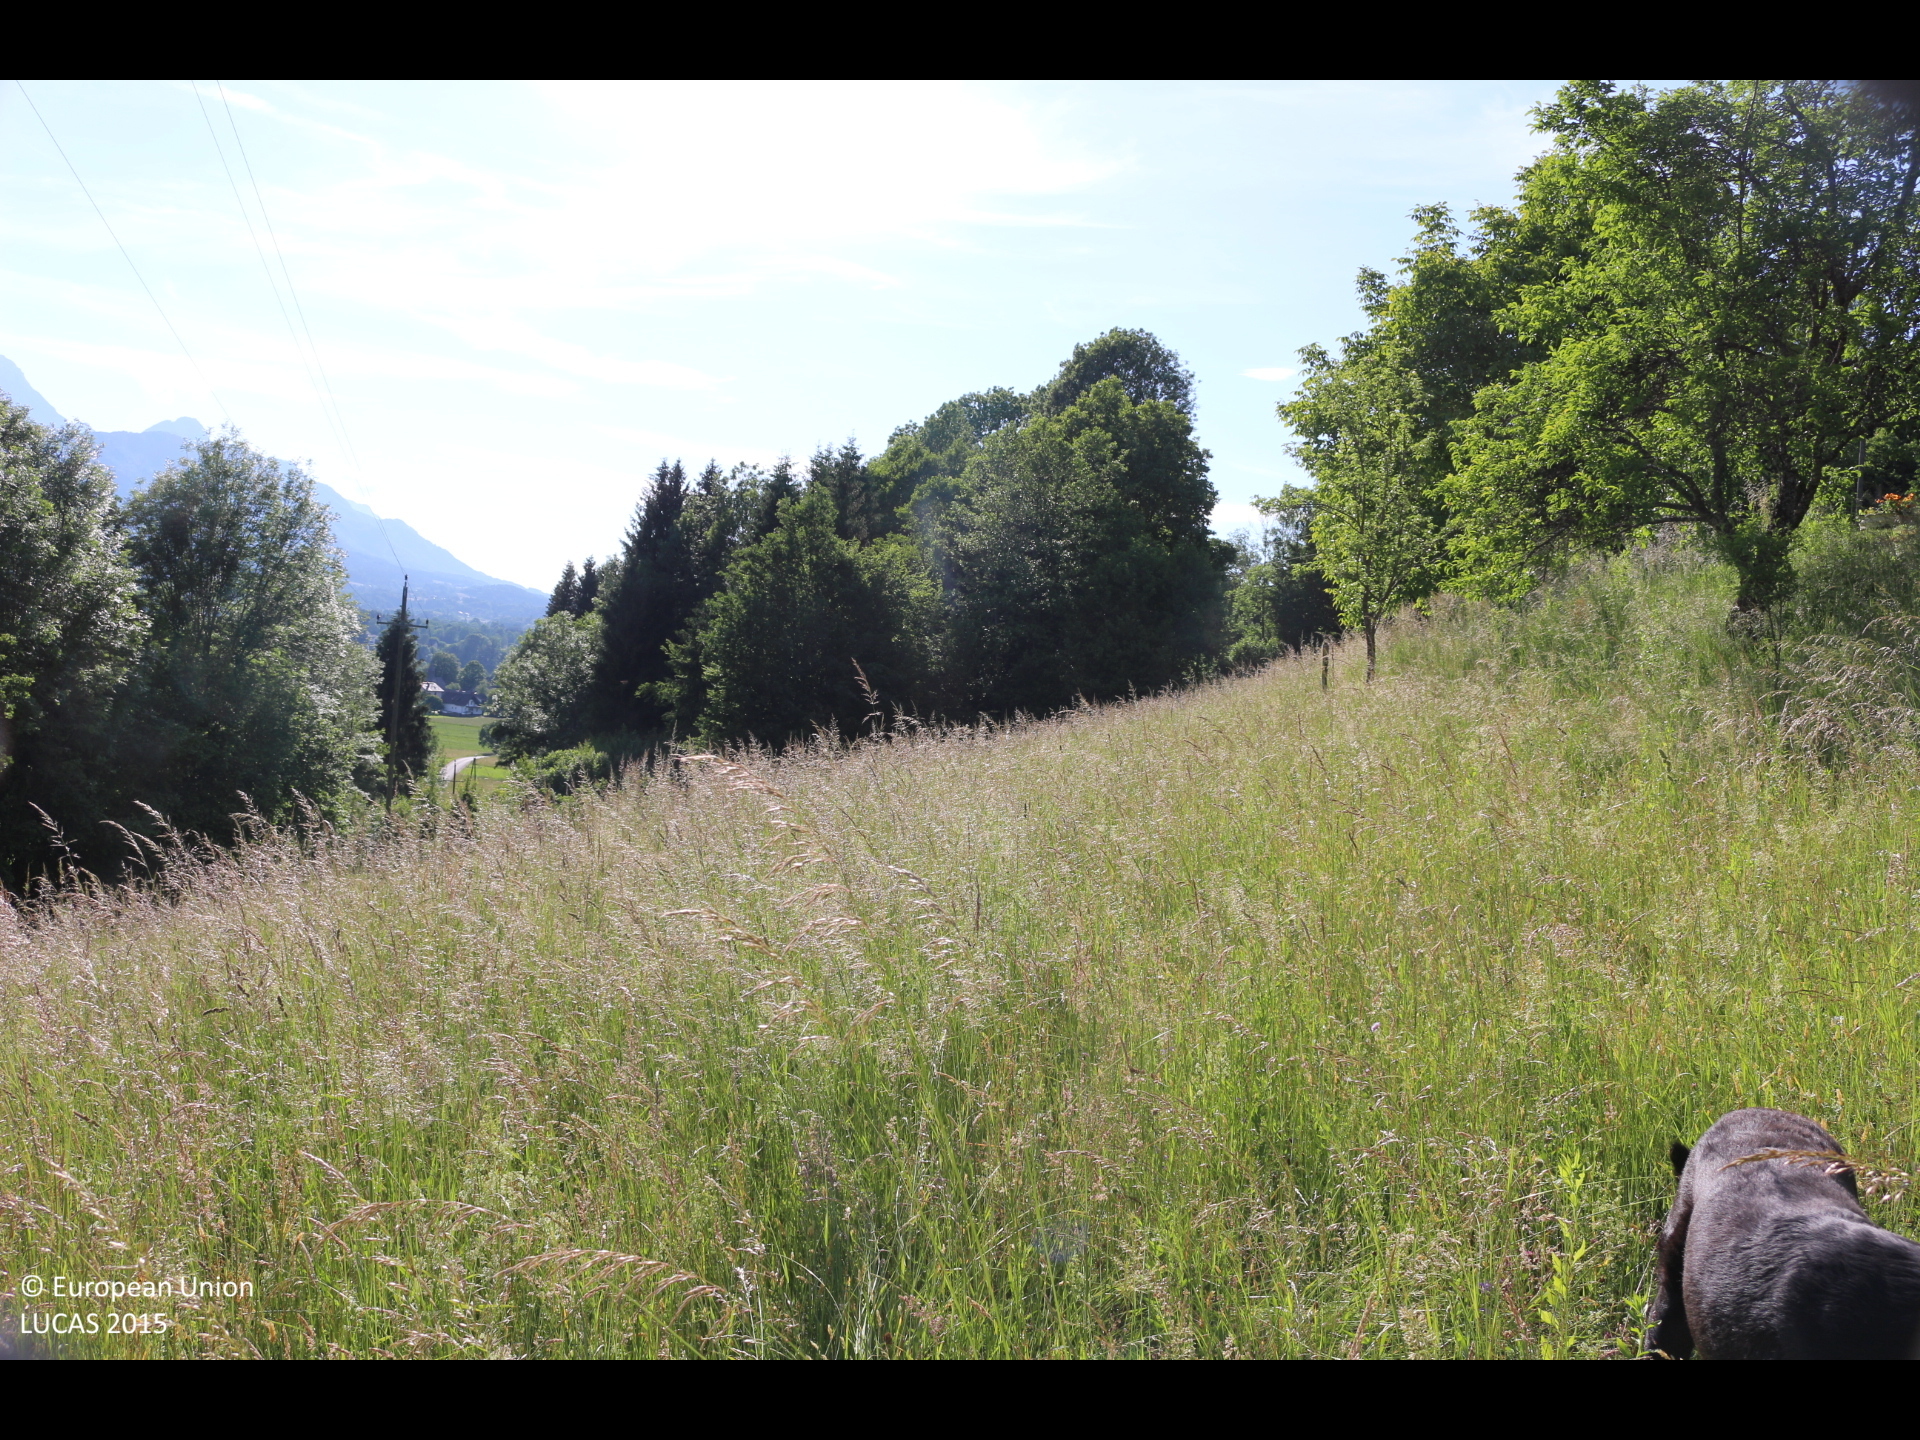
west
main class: Grassland
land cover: Grassland without tree/shrub cover
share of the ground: > 75 %
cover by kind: herbaceous plants 100 %
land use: Agriculture (excluding fallow land and kitchen gardens)
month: May
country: AT
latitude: 46.5429
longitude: 14.1050
